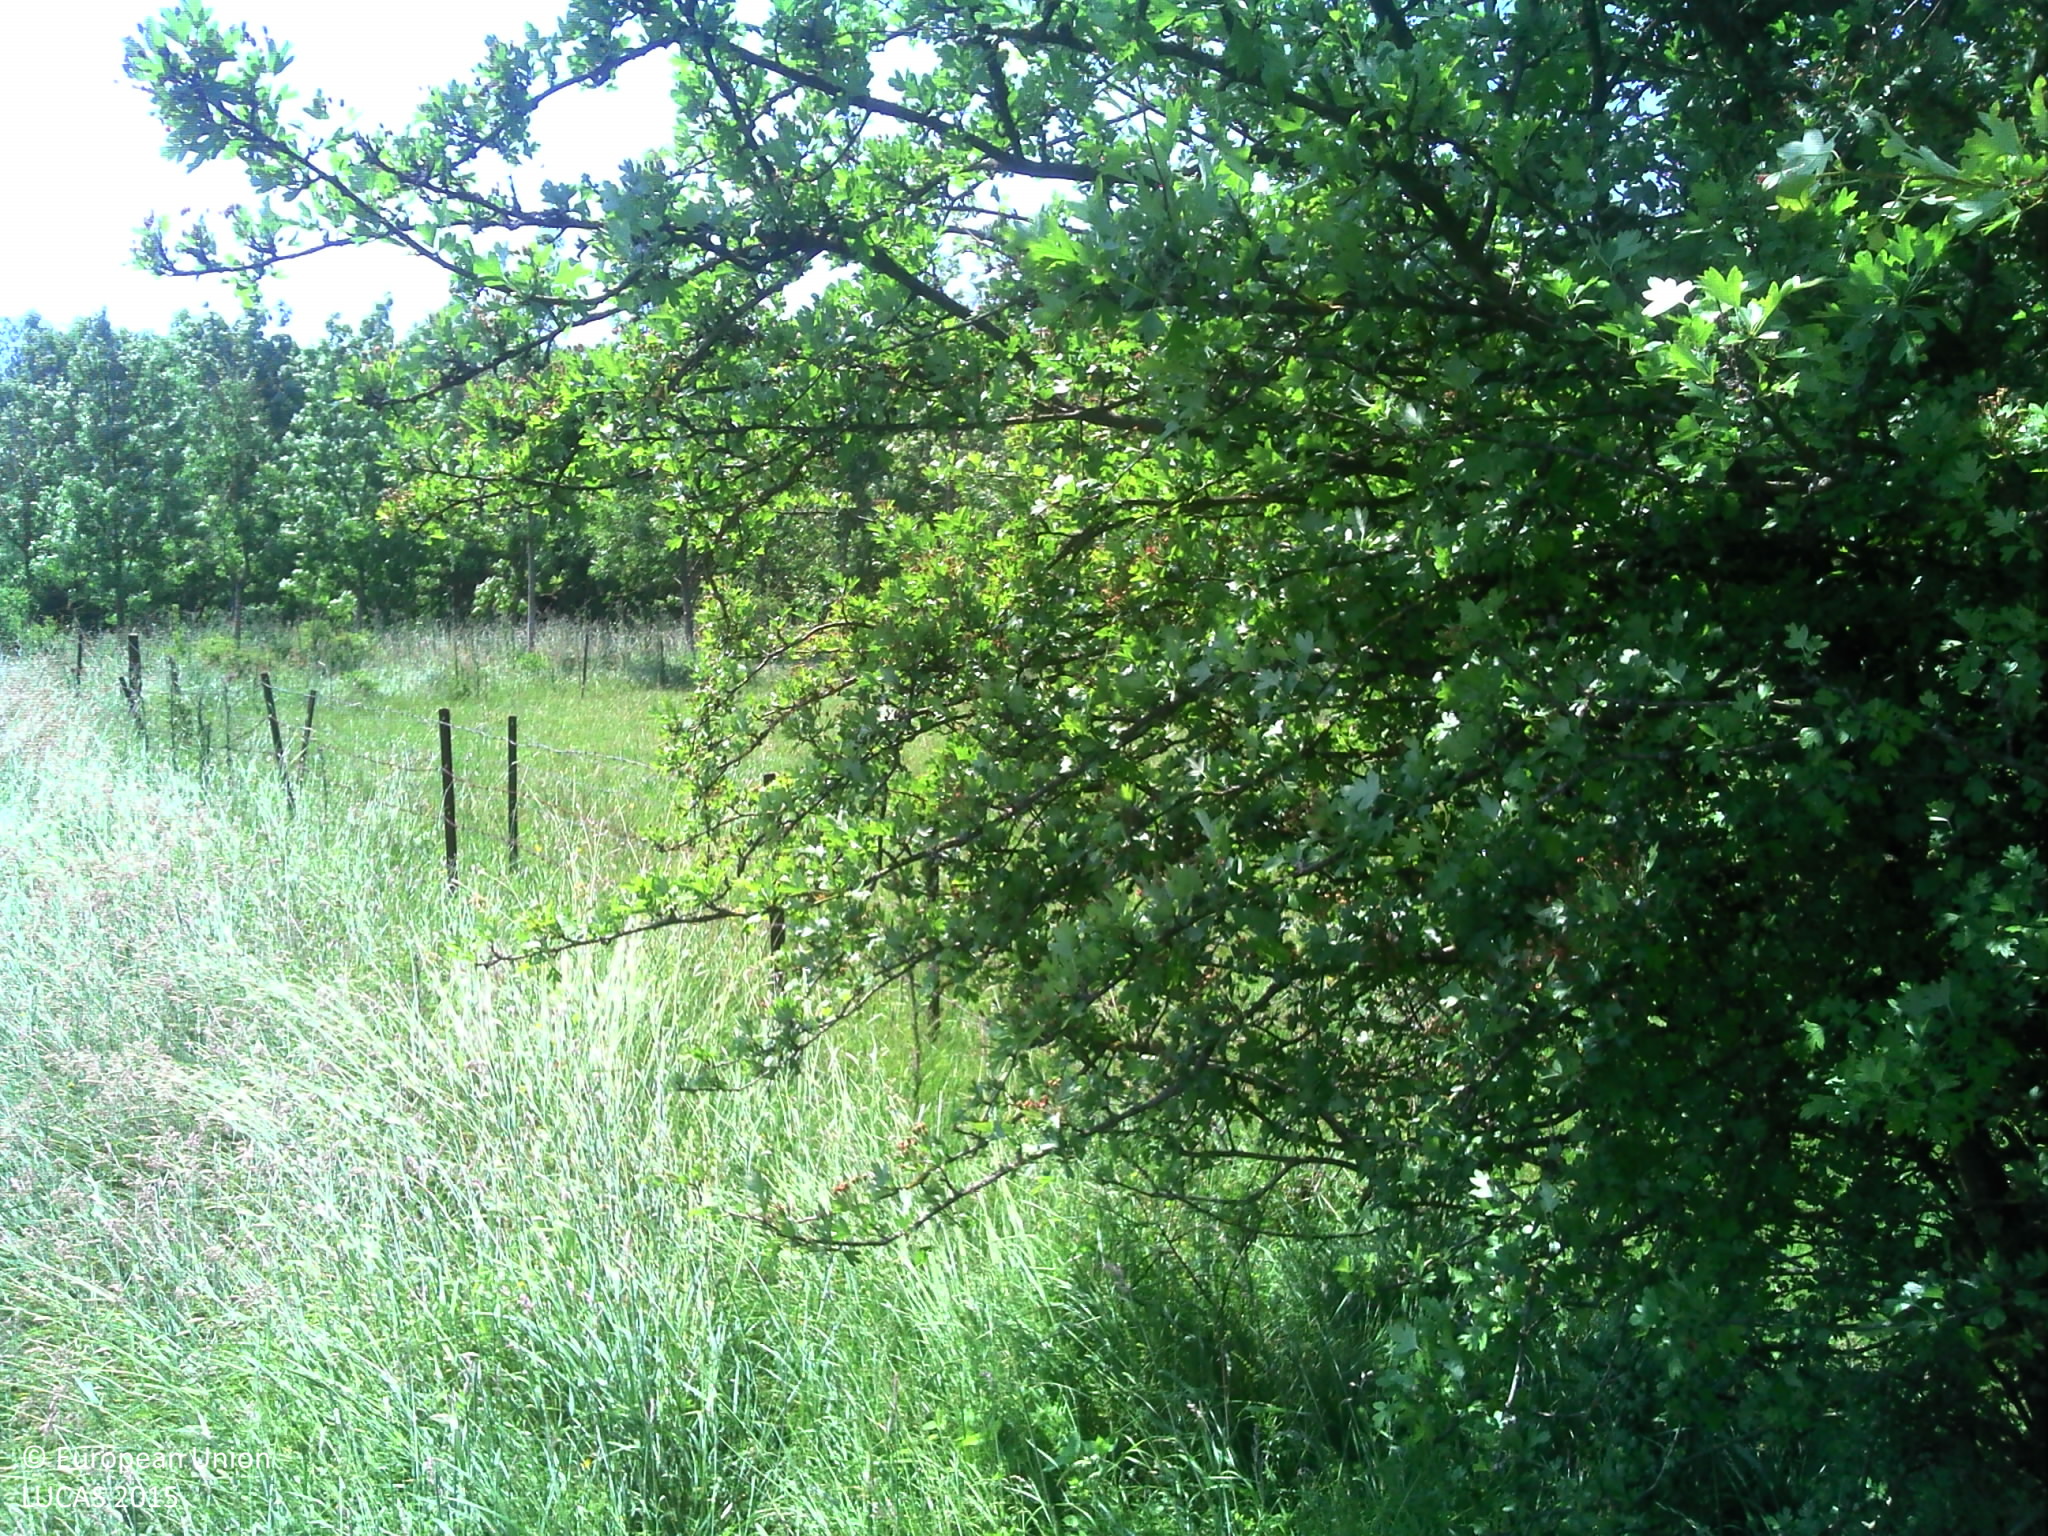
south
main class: Grassland
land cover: Grassland without tree/shrub cover
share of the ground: > 75 %
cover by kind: herbaceous plants 100 %
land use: Agriculture (excluding fallow land and kitchen gardens)
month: June
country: FR
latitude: 49.8159
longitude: 4.1161
